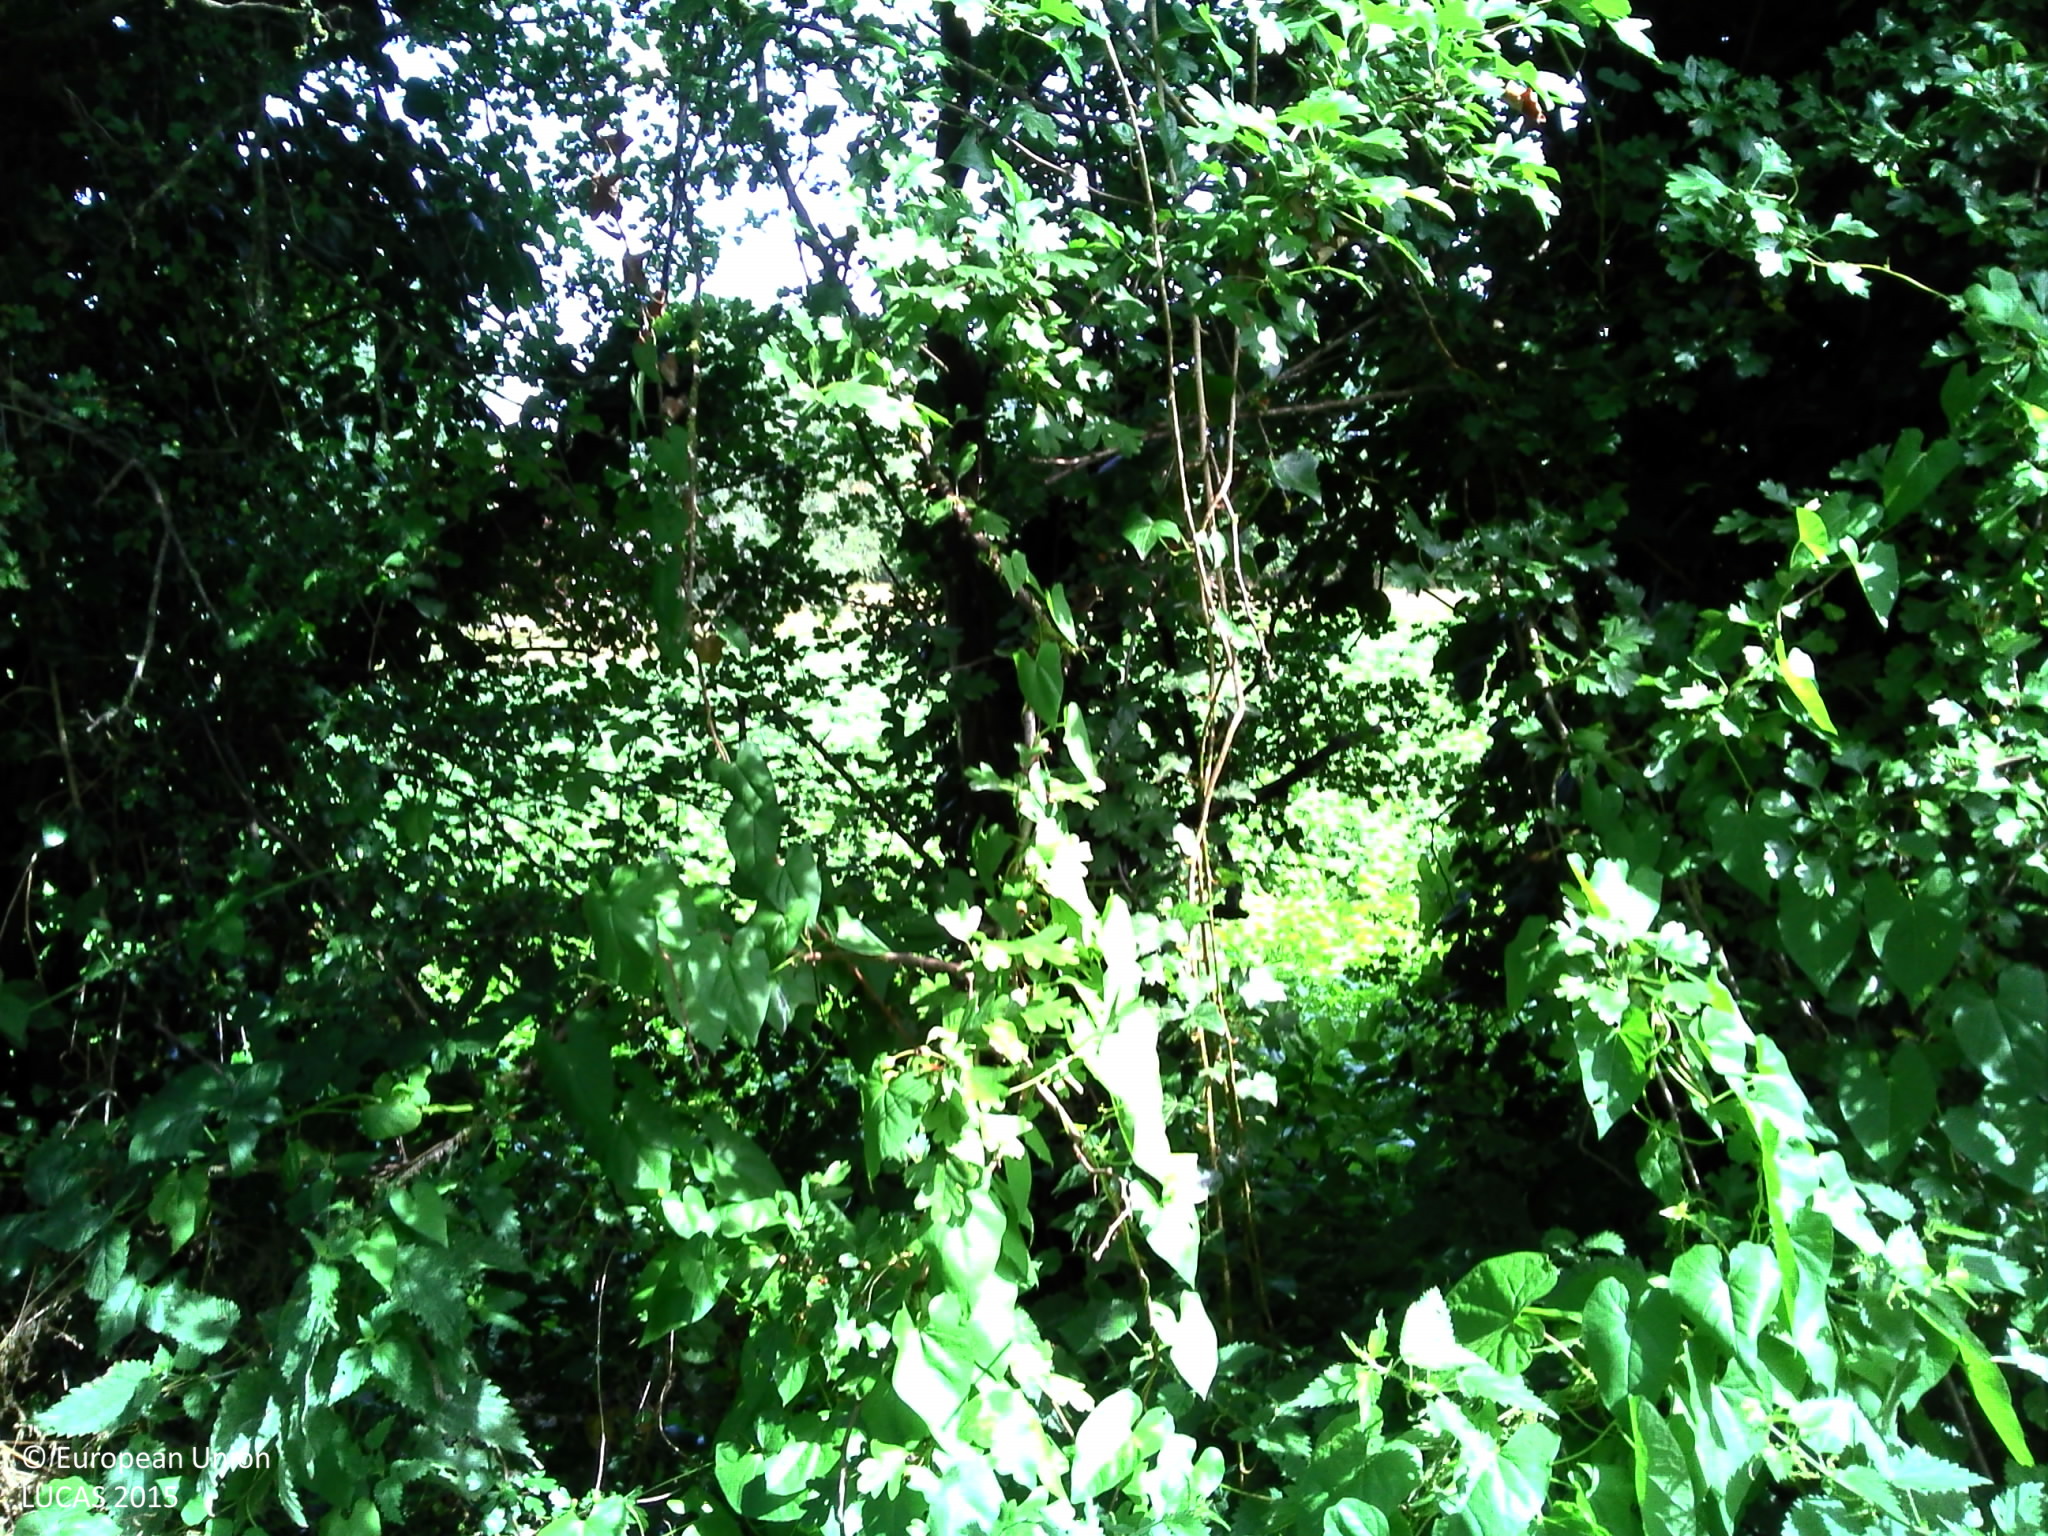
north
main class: Shrubland
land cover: Shrubland with sparse tree cover
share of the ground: > 75 %
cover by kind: shrubs 60 %, herbaceous plants 35 %, broadleaved forest trees 5 %
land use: Abandoned areas
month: July
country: BE
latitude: 50.5756
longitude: 4.1628
